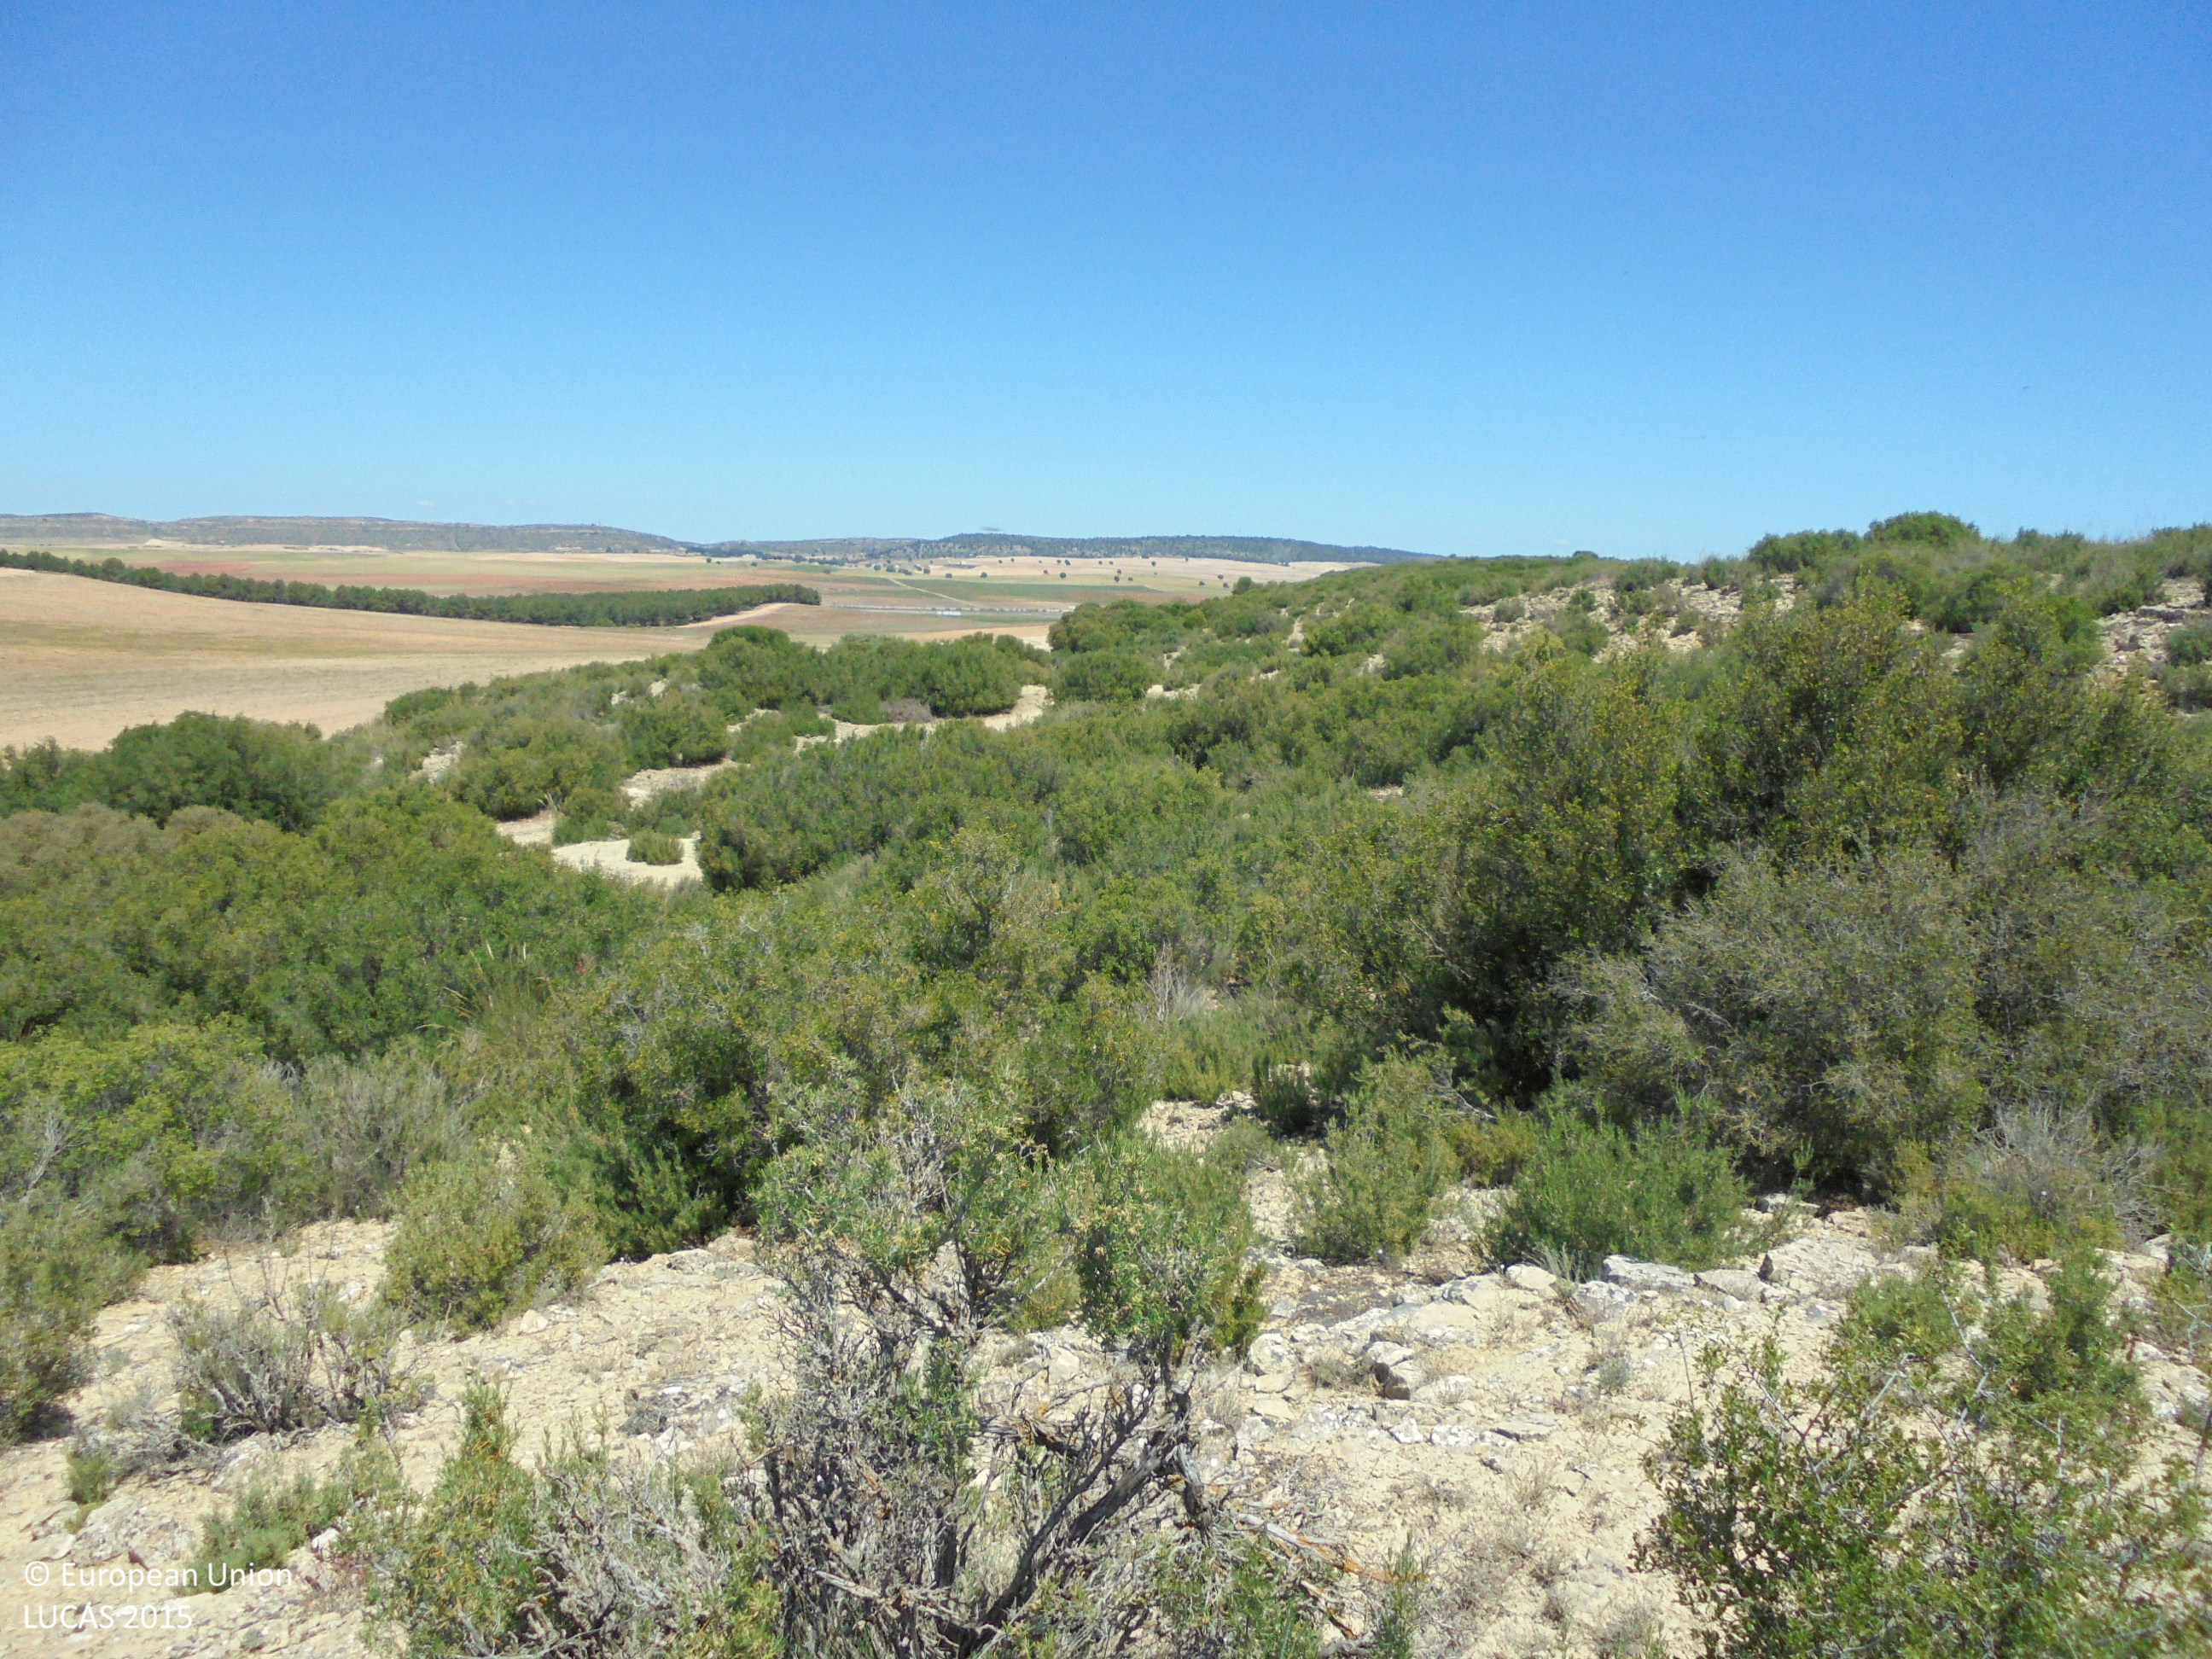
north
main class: Shrubland
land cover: Shrubland without tree cover
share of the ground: 50 - 75 %
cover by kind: shrubs 65 %, unconsolidated bare surface 35 %
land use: Semi-natural and natural areas not in use
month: May
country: ES
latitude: 38.8942
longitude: -1.6542
